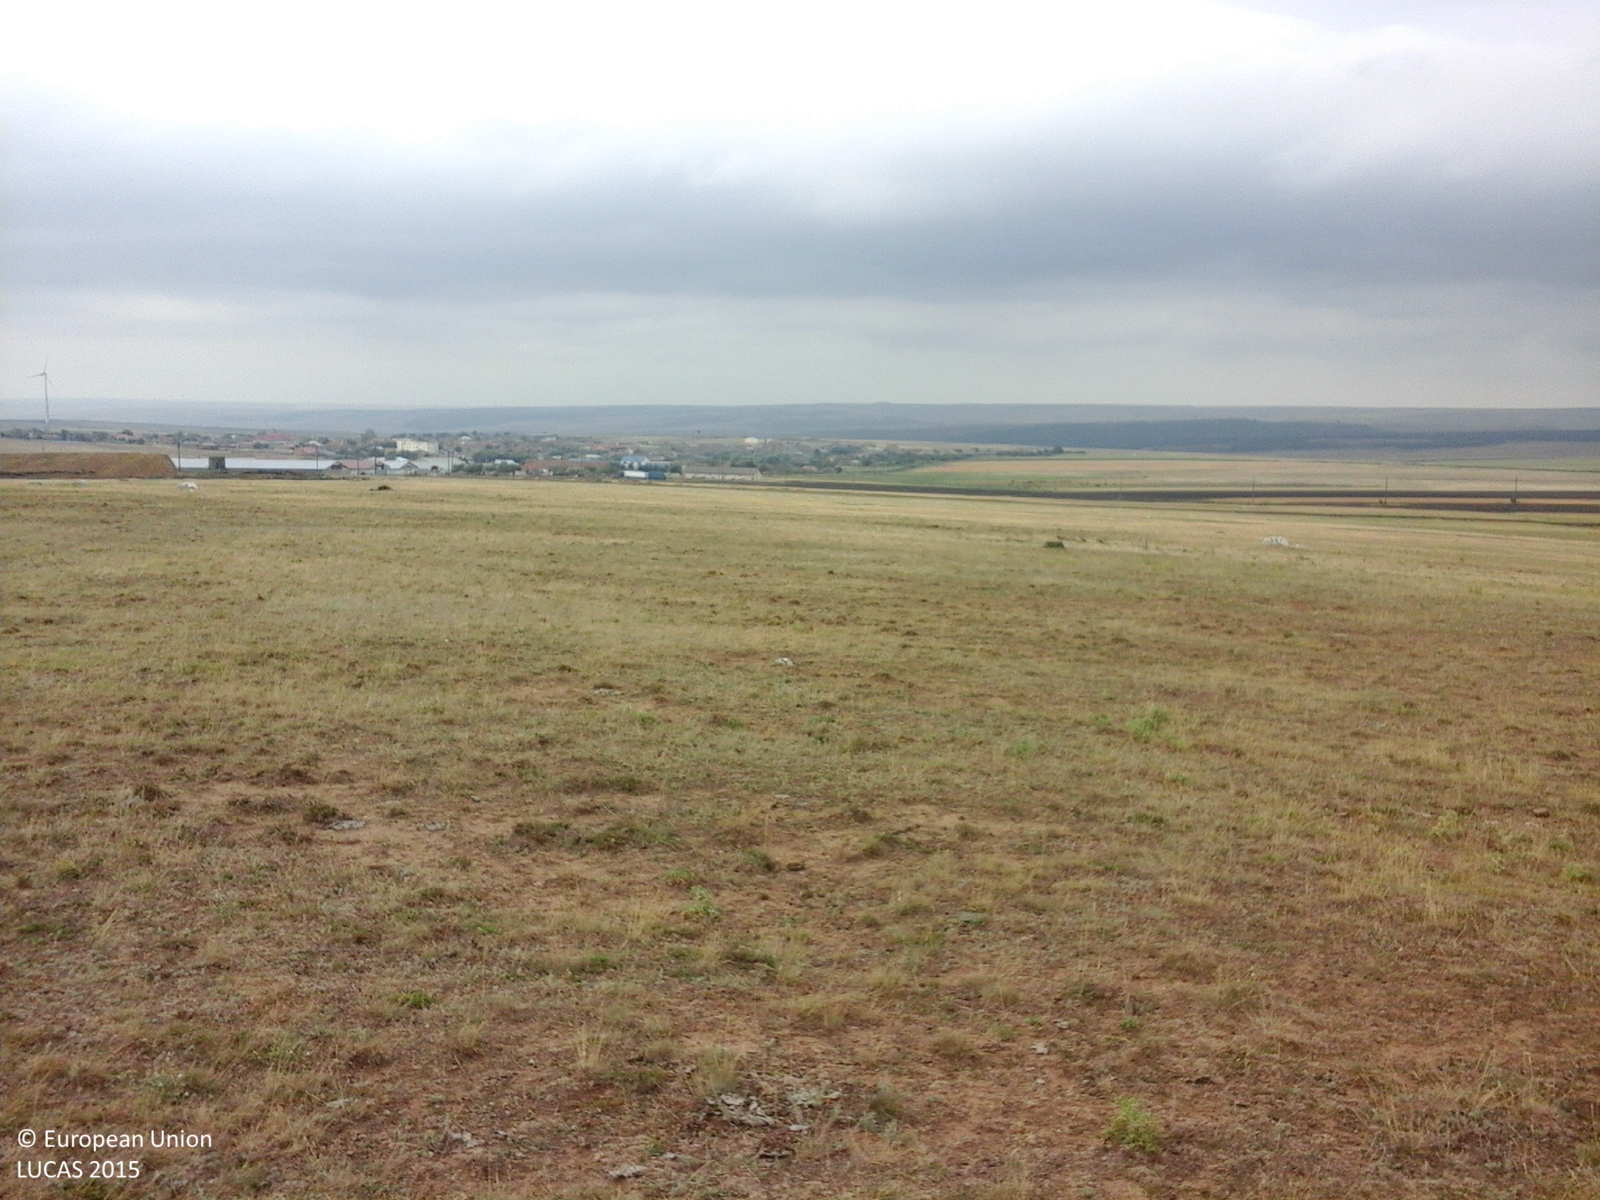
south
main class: Grassland
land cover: Grassland without tree/shrub cover
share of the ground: > 75 %
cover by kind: herbaceous plants 100 %
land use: Agriculture (excluding fallow land and kitchen gardens)
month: August
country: RO
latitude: 44.7851
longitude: 28.5426
